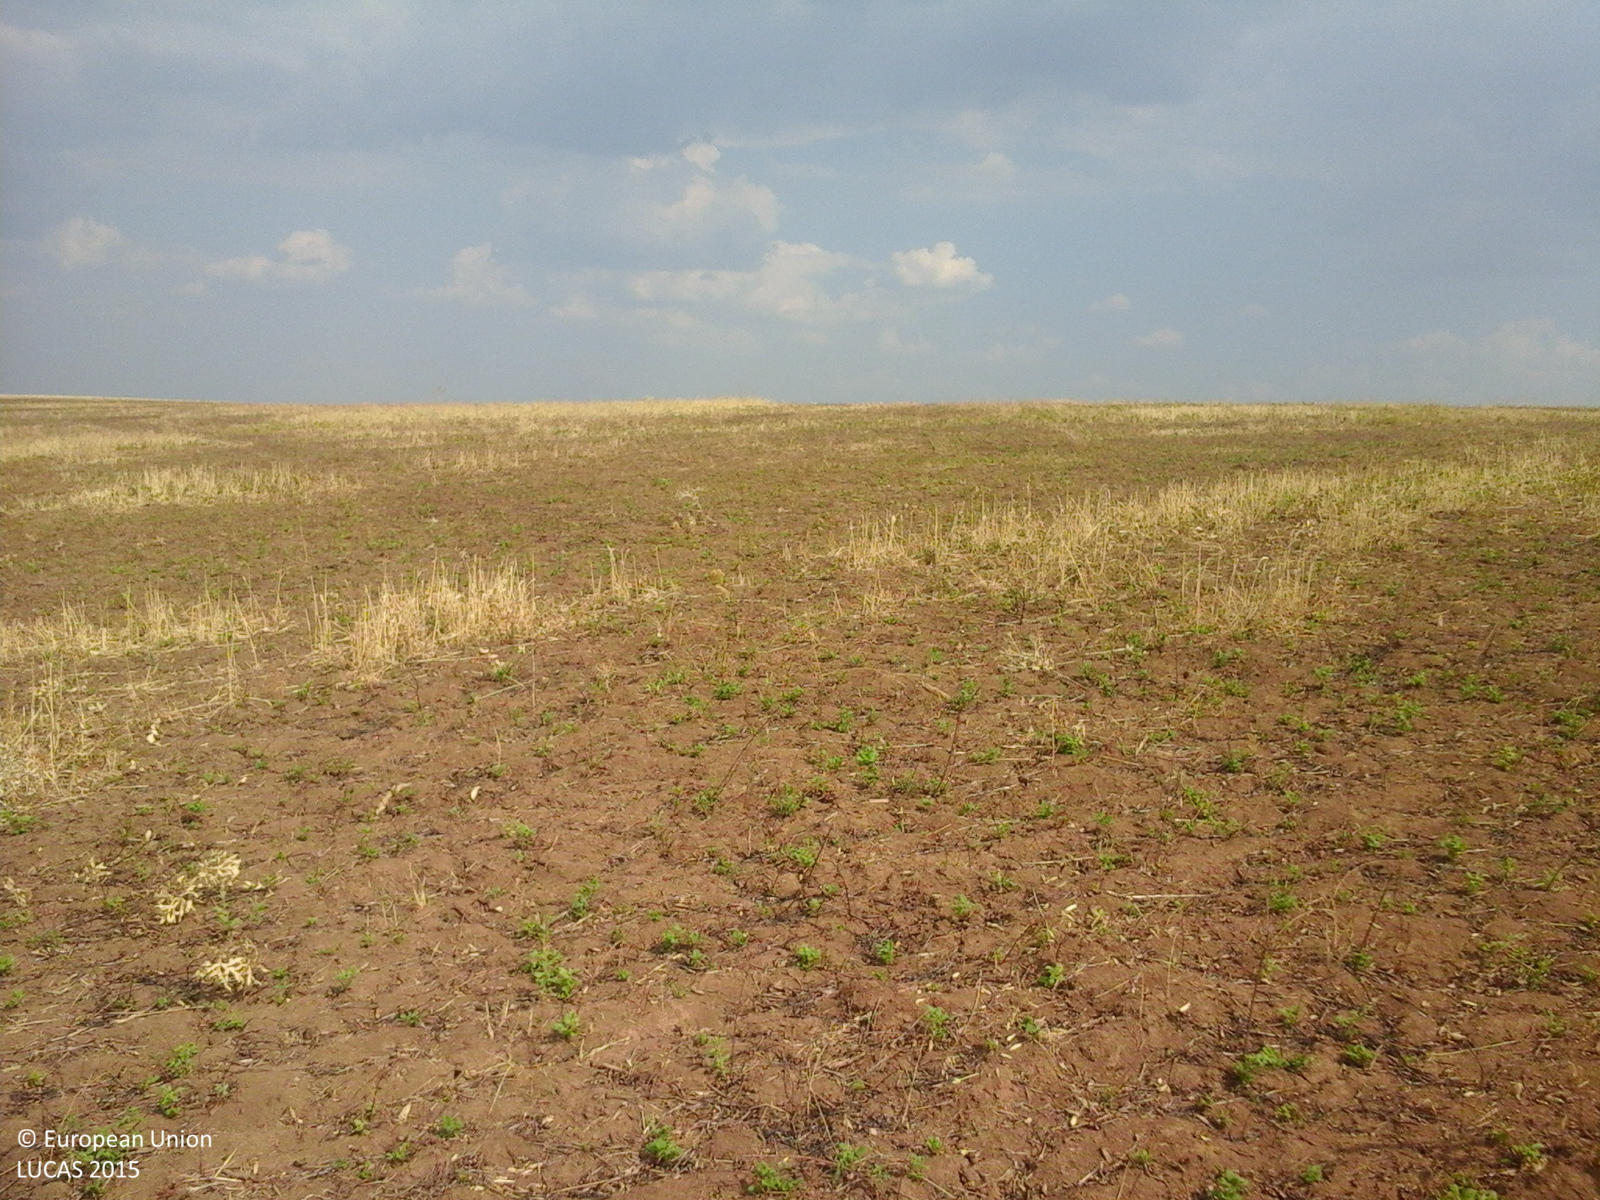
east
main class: Cropland
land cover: Common wheat
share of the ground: < 10 %
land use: Agriculture (excluding fallow land and kitchen gardens)
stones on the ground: < 10 %
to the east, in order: Common wheat
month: August
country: RO
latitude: 44.3611
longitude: 23.0567
